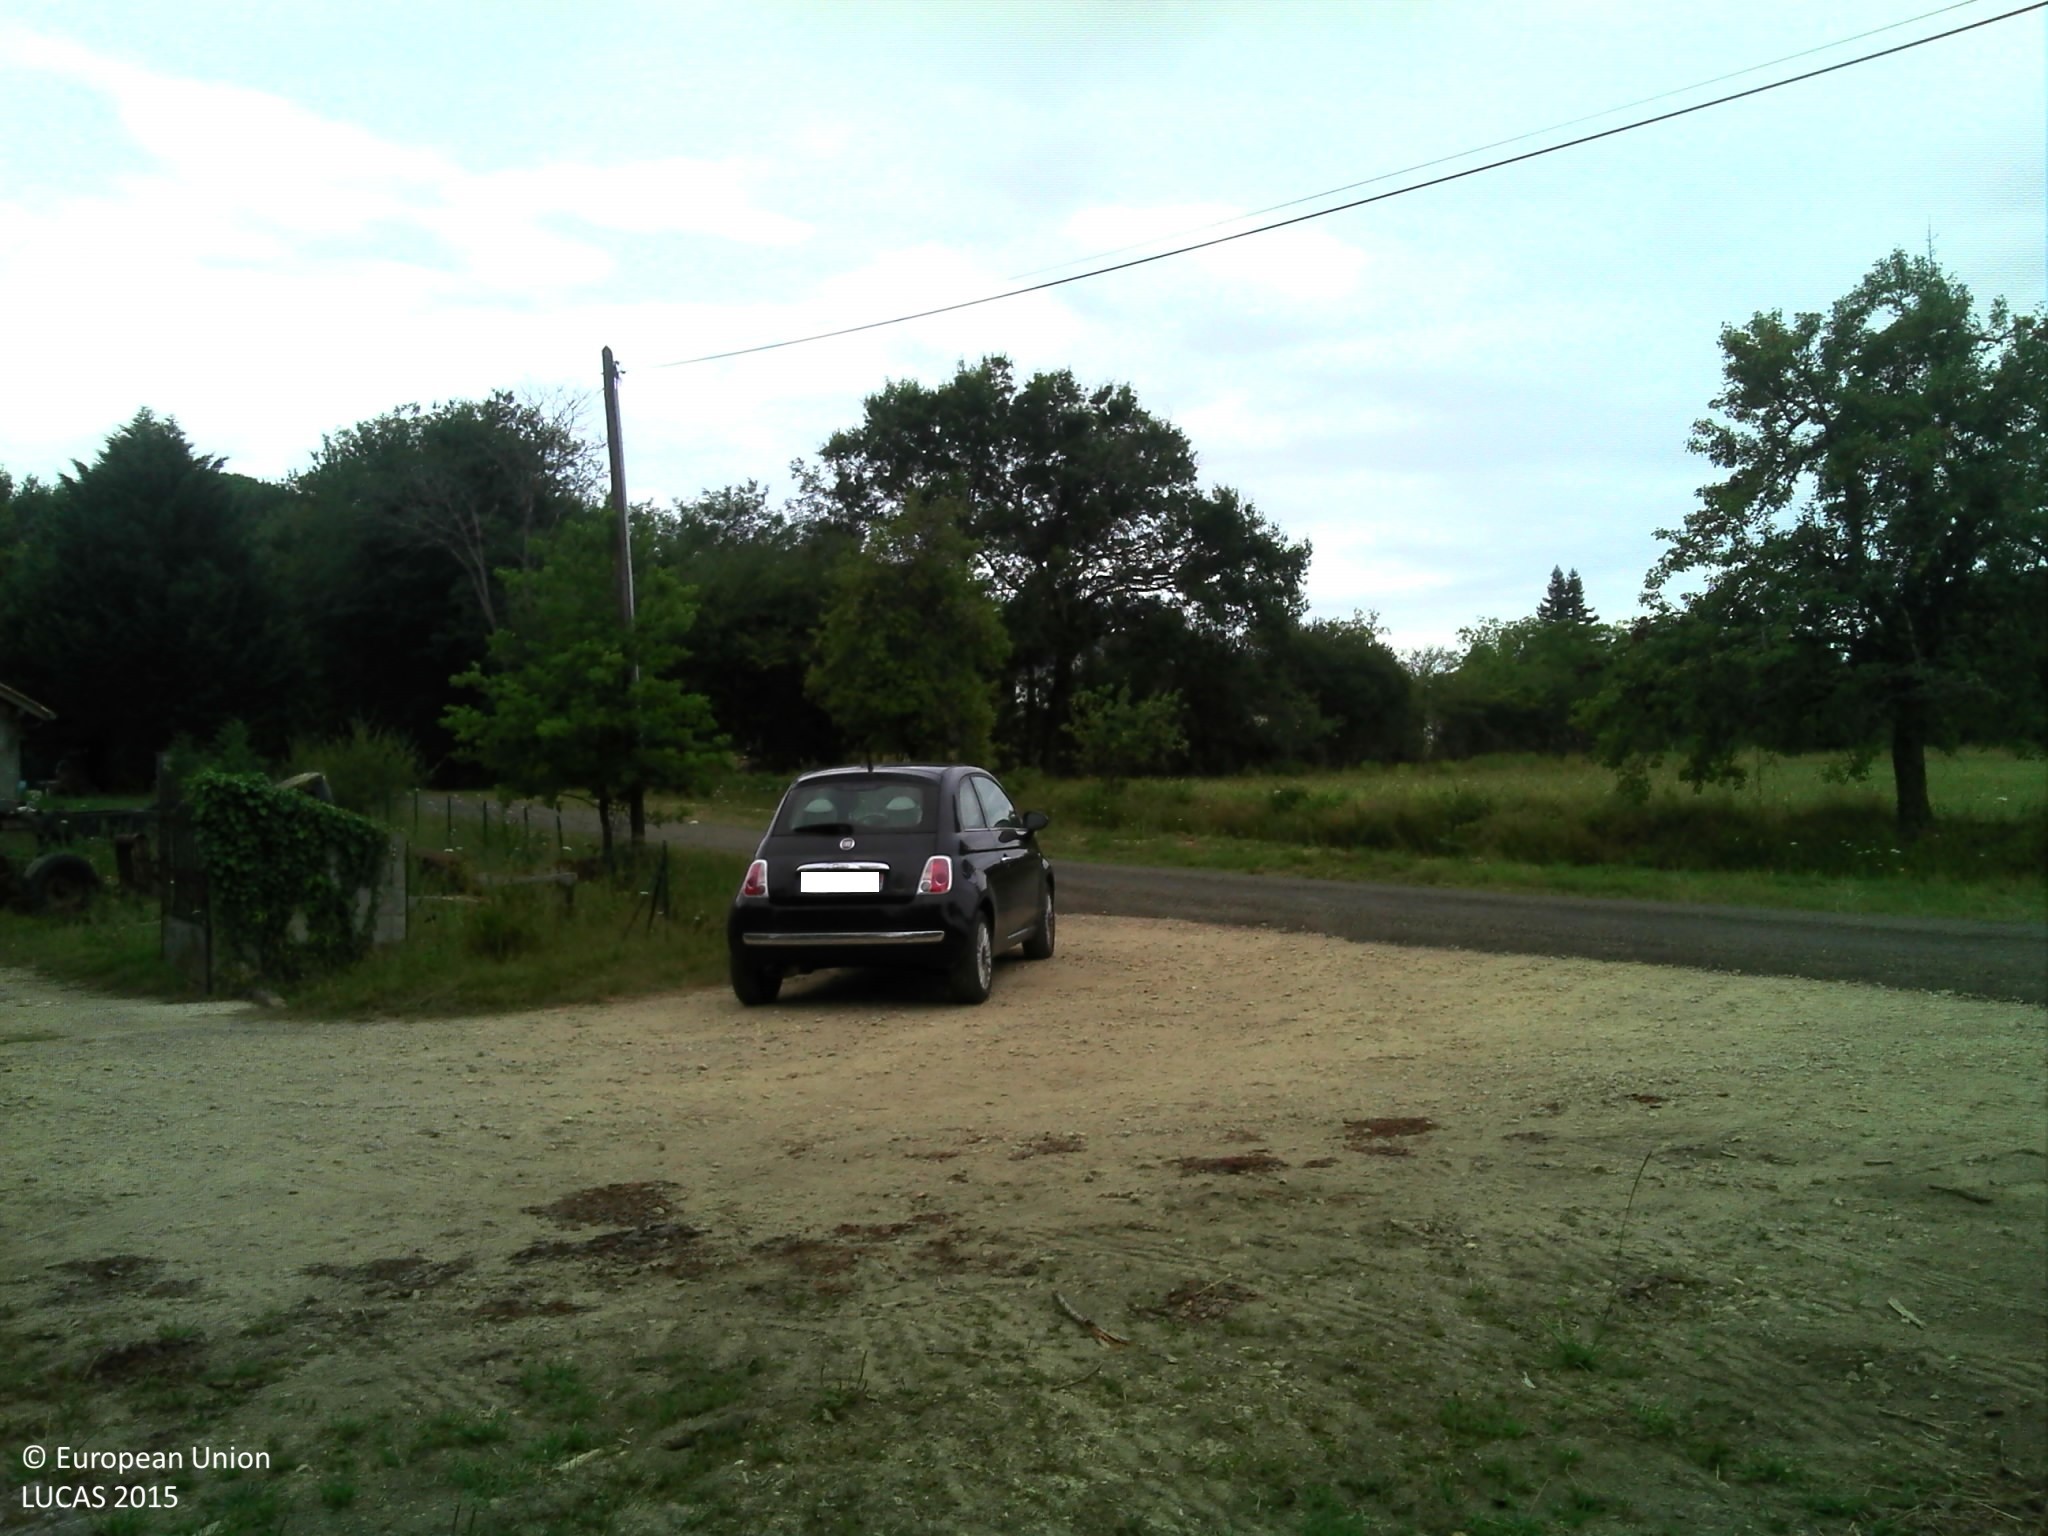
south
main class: Woodland
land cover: Pine dominated coniferous woodland
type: coniferous forest of the mediterranean region
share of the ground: > 75 %
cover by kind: coniferous forest trees 75 %, herbaceous plants 20 %, shrubs 5 %
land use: Forestry
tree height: < 5 m
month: July
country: FR
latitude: 43.9292
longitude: -0.8144
